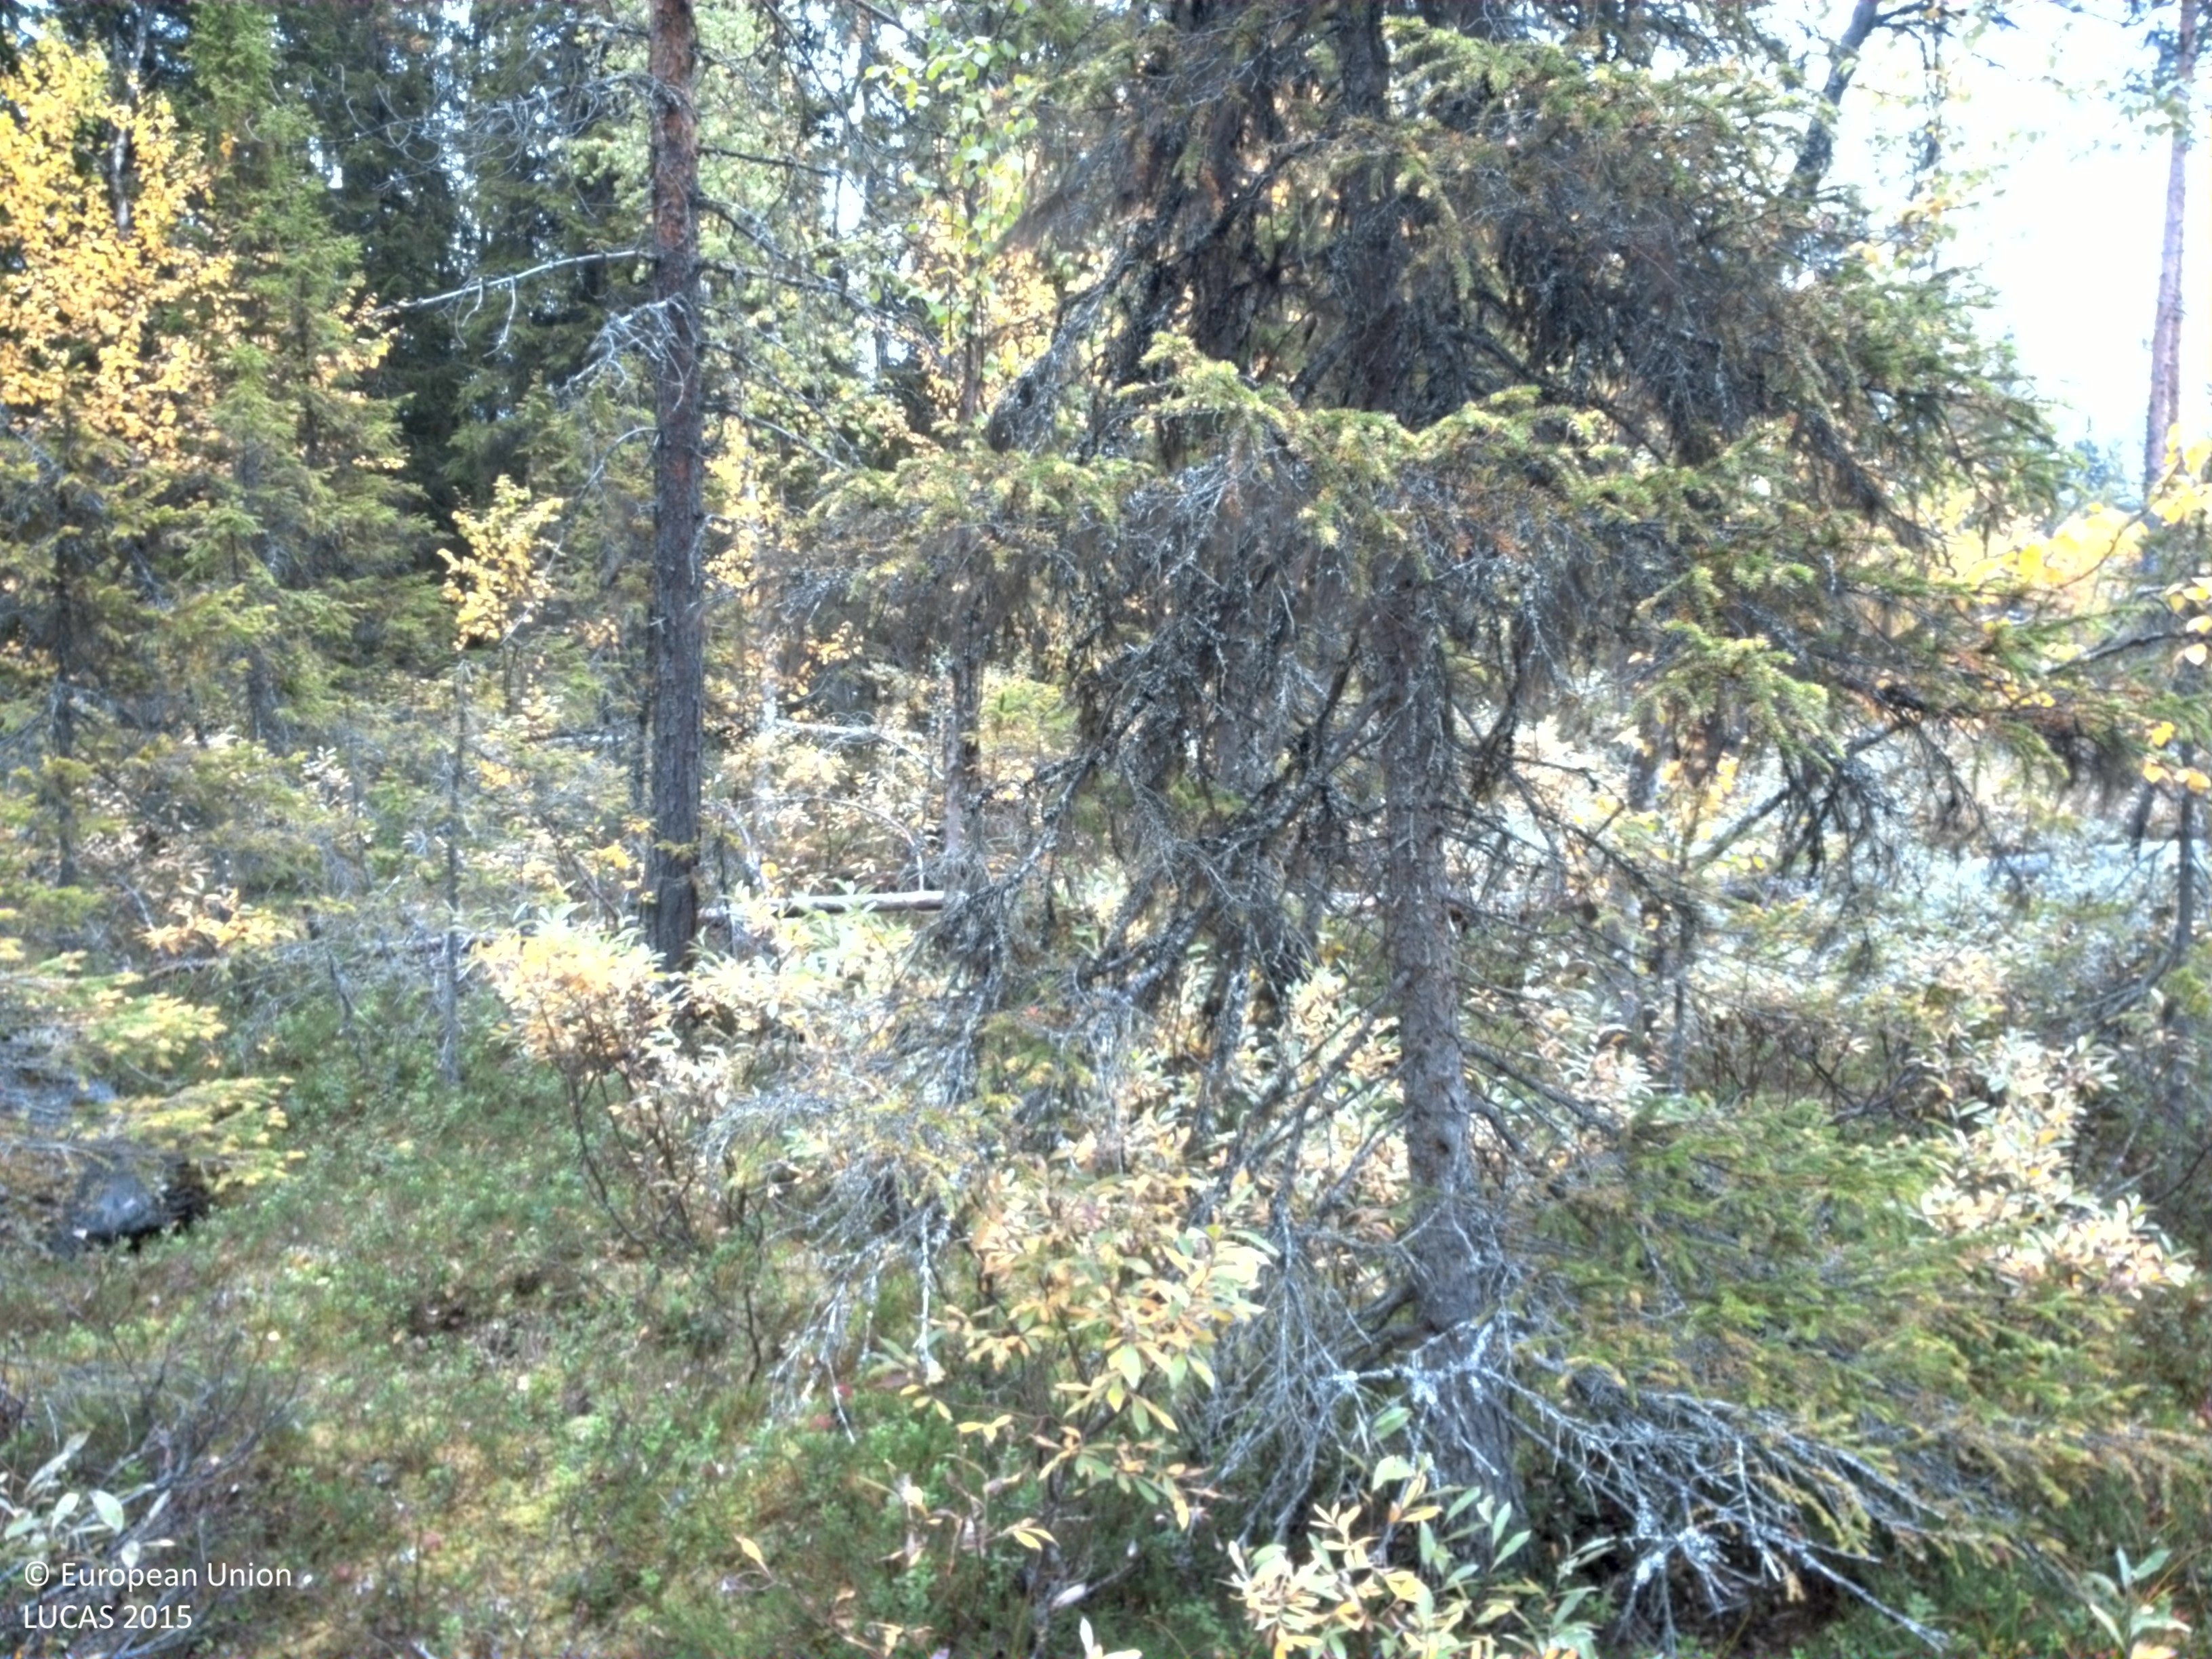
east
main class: Woodland
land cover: Spruce dominated coniferous woodland
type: boreal forest
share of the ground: 25 - 50 %
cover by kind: shrubs 40 %, coniferous forest trees 35 %, lichens and mosses 15 %, broadleaved forest trees 5 %, herbaceous plants 5 %
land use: Forestry
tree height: > 5 m
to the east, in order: Spruce dominated coniferous woodland; Spruce dominated mixed woodland; Pine dominated mixed woodland; Rocks and stones; Other mixed woodland; Spruce dominated mixed woodland; Shrubland with sparse tree cover; Peatbogs; Inland fresh water bodies; Peatbogs; Shrubland with sparse tree cover; Peatbogs; Pine dominated coniferous woodland
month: September
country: SE
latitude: 65.1176
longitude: 16.9284
